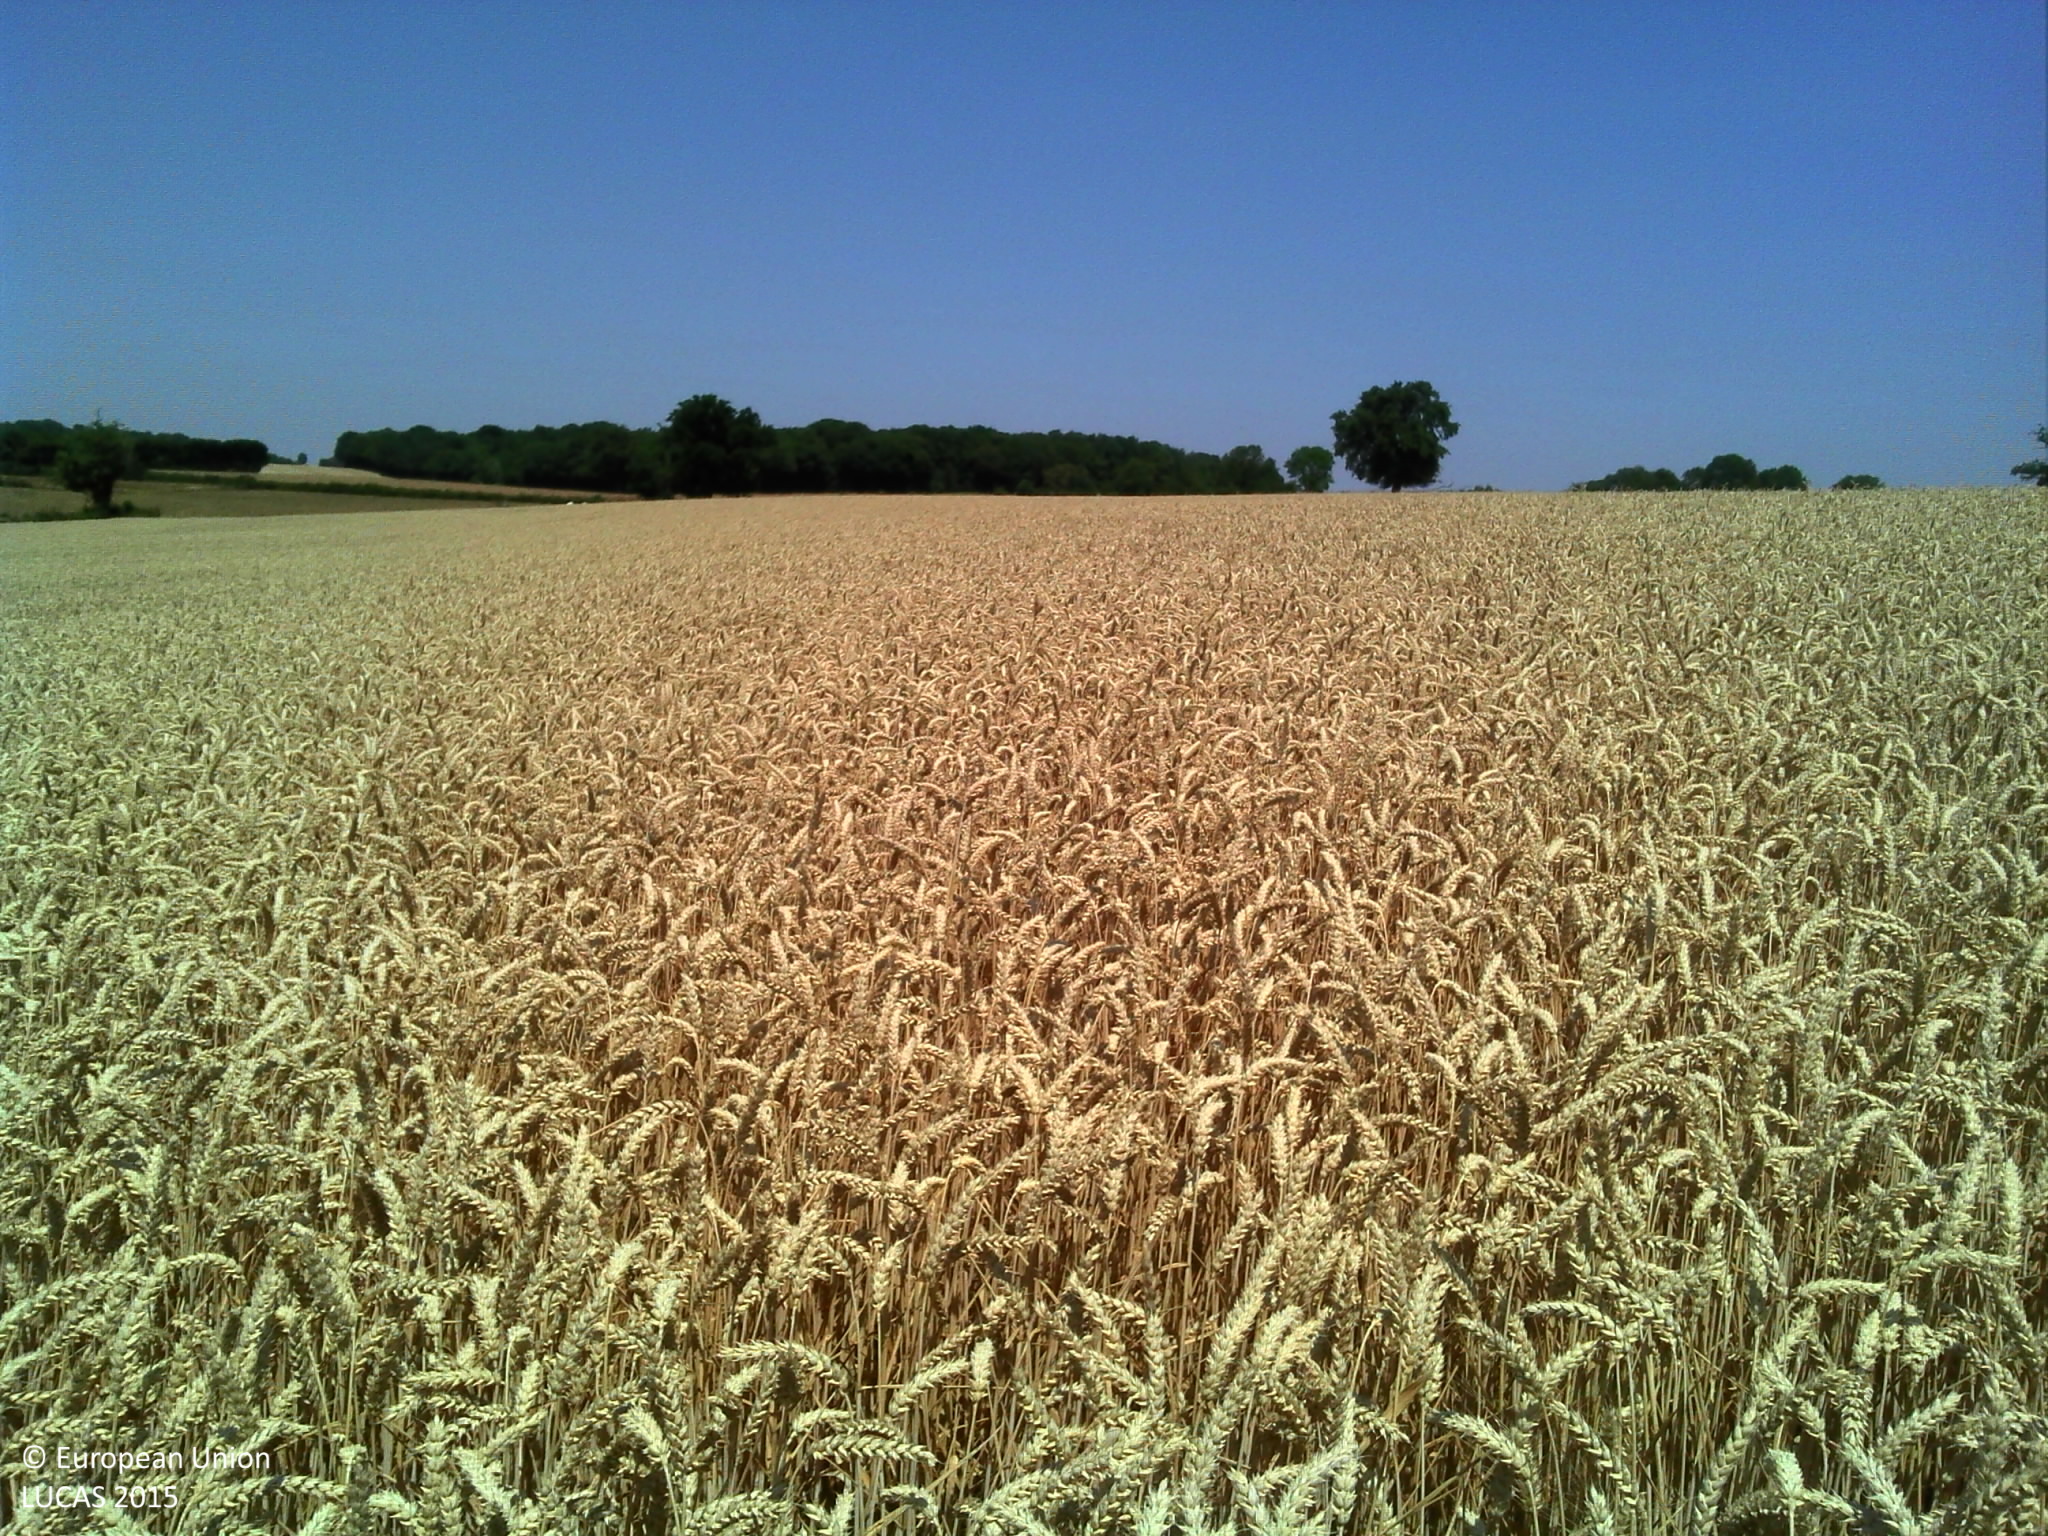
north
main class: Cropland
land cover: Common wheat
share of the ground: > 75 %
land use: Agriculture (excluding fallow land and kitchen gardens)
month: July
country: FR
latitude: 47.0259
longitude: 3.5900
